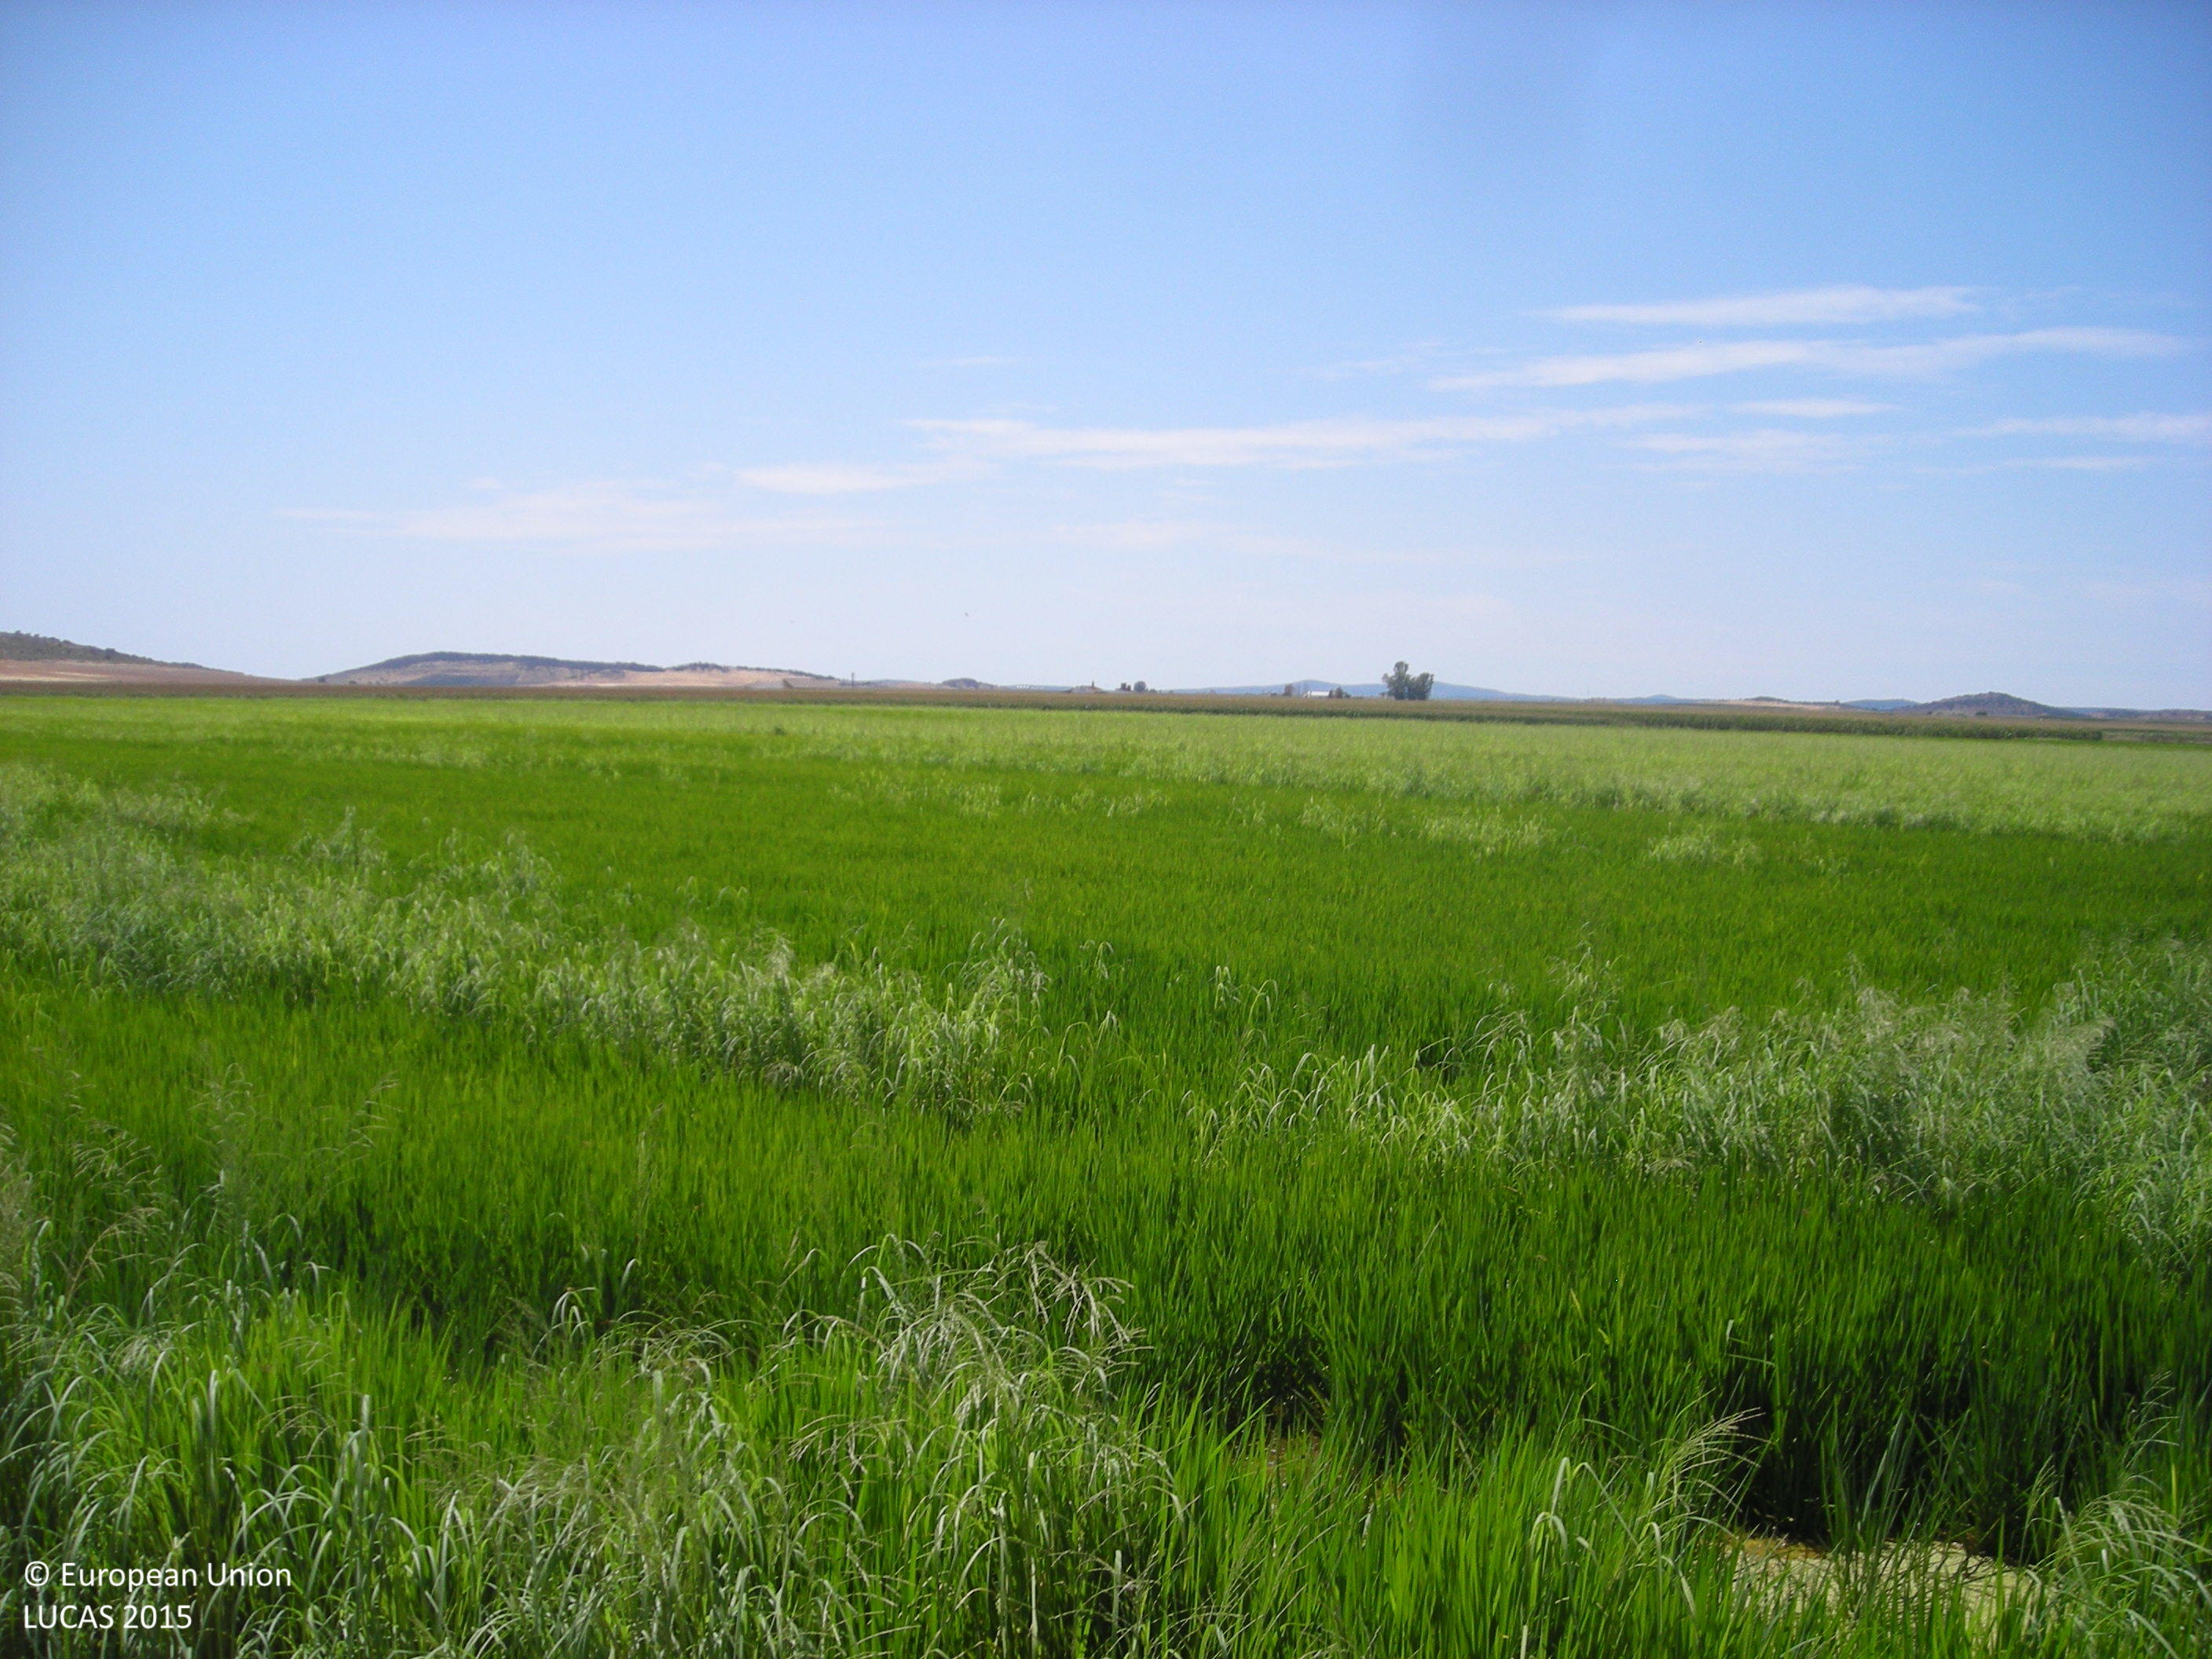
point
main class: Cropland
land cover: Rice
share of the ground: > 75 %
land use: Agriculture (excluding fallow land and kitchen gardens)
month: July
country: ES
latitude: 39.0114
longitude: -5.9308
